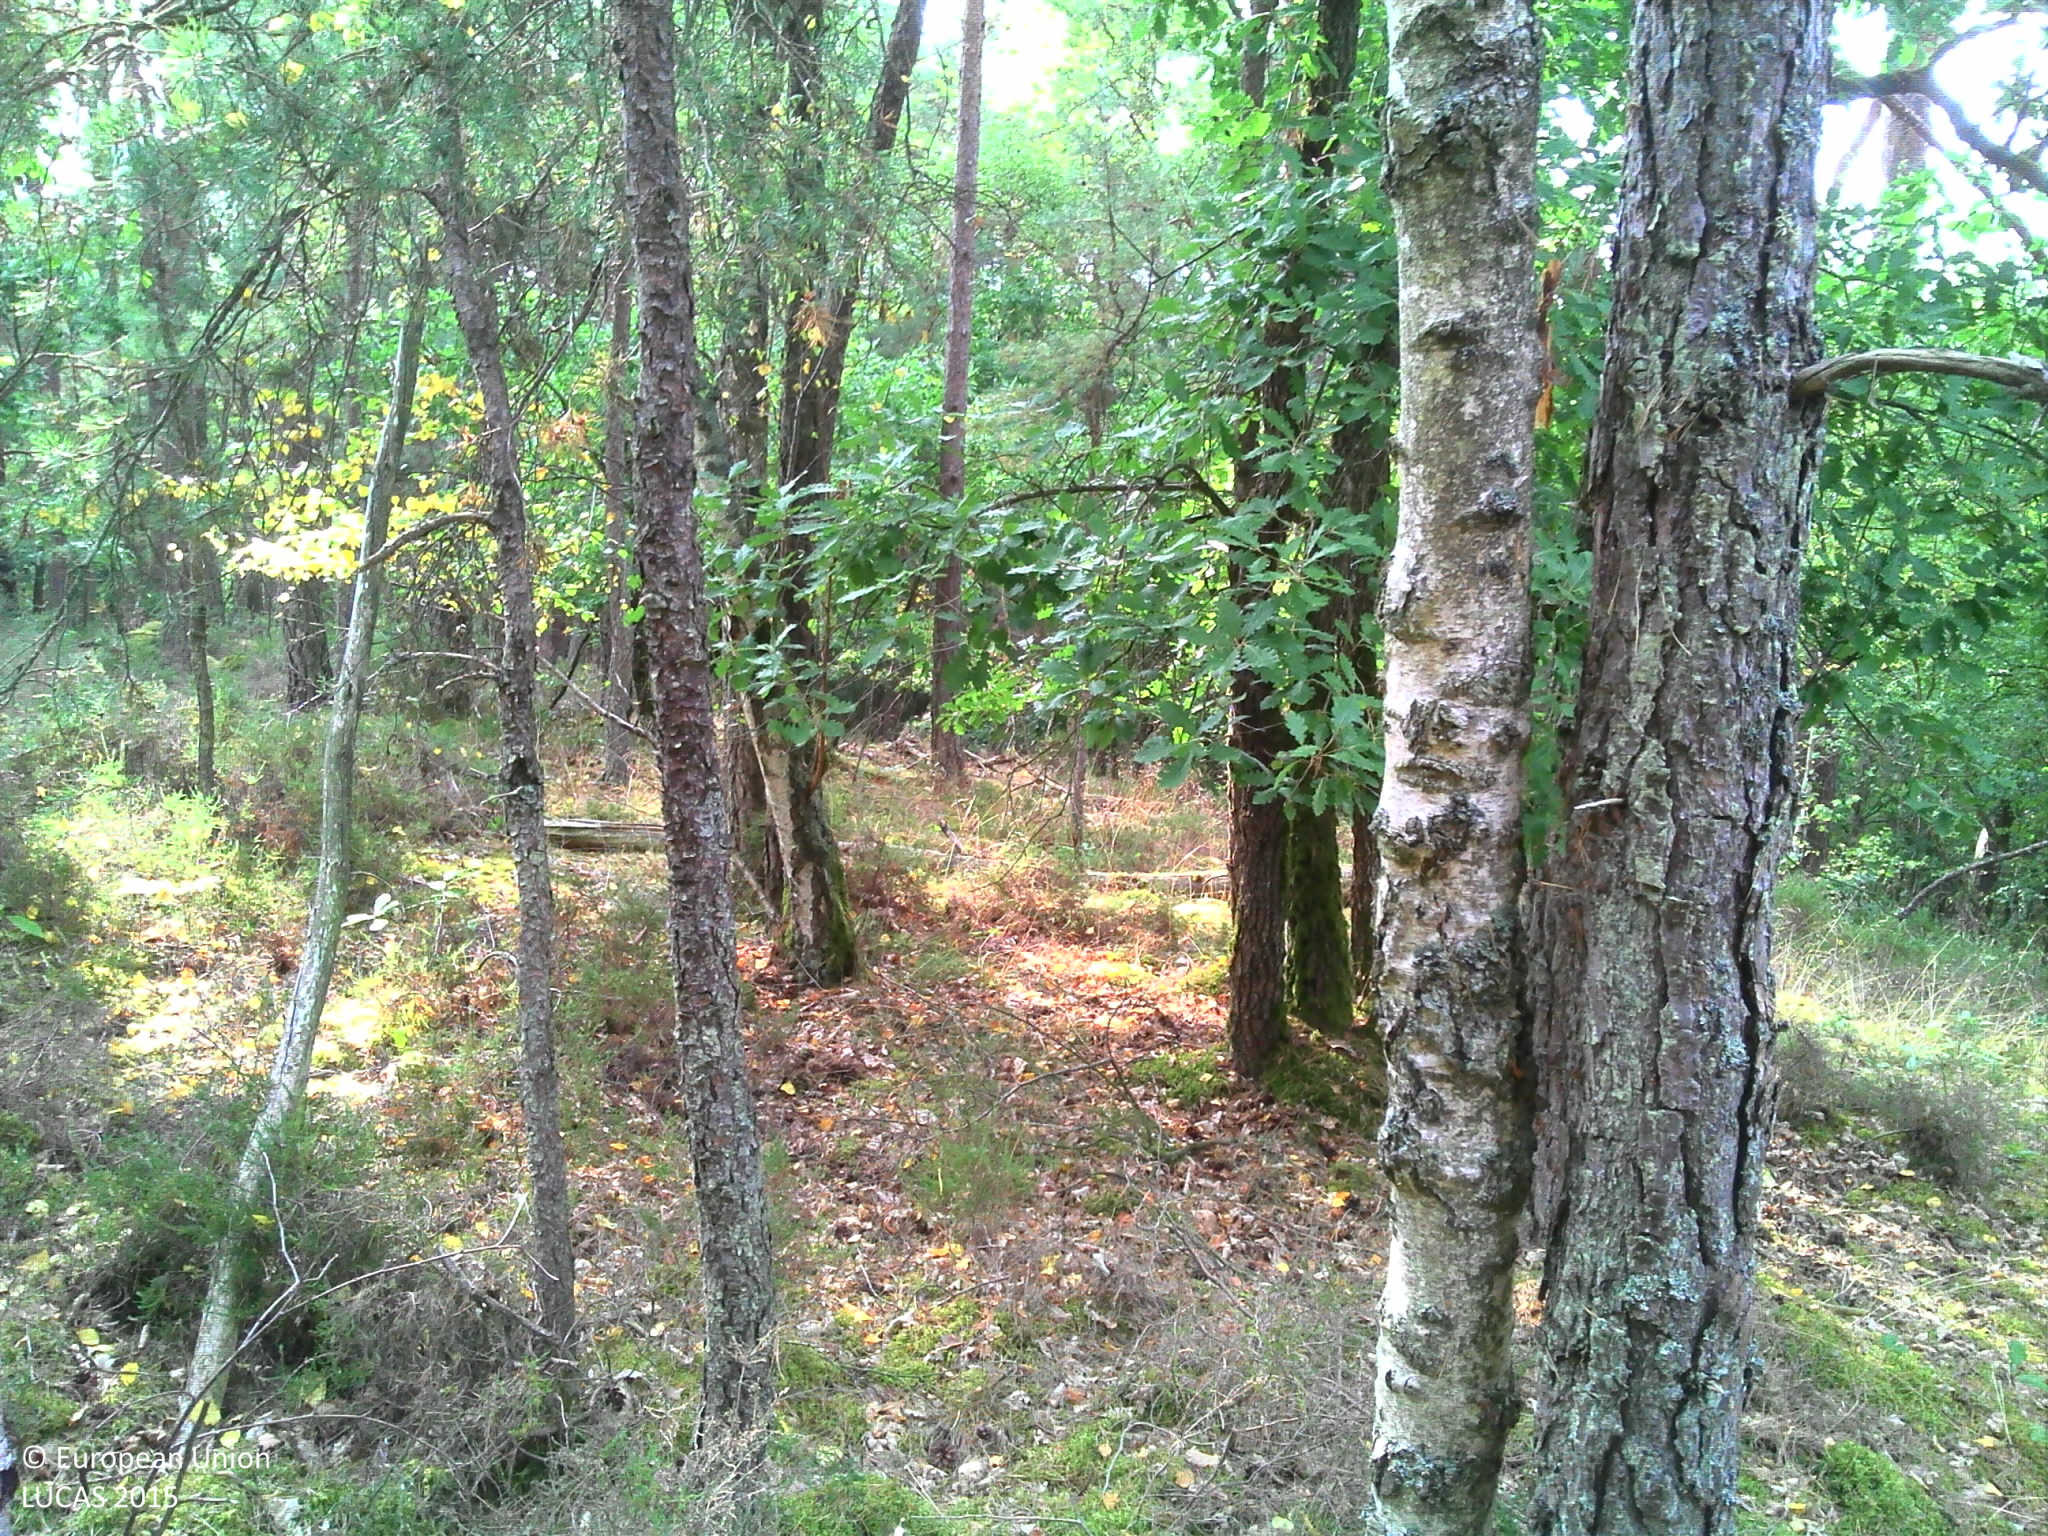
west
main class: Woodland
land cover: Pine dominated mixed woodland
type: acidophilous oak and oak-birch forest
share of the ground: > 75 %
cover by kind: lichens and mosses 50 %, coniferous forest trees 30 %, broadleaved forest trees 10 %, shrubs 10 %
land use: Forestry
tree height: > 5 m
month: August
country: FR
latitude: 48.3295
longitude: 2.5036
